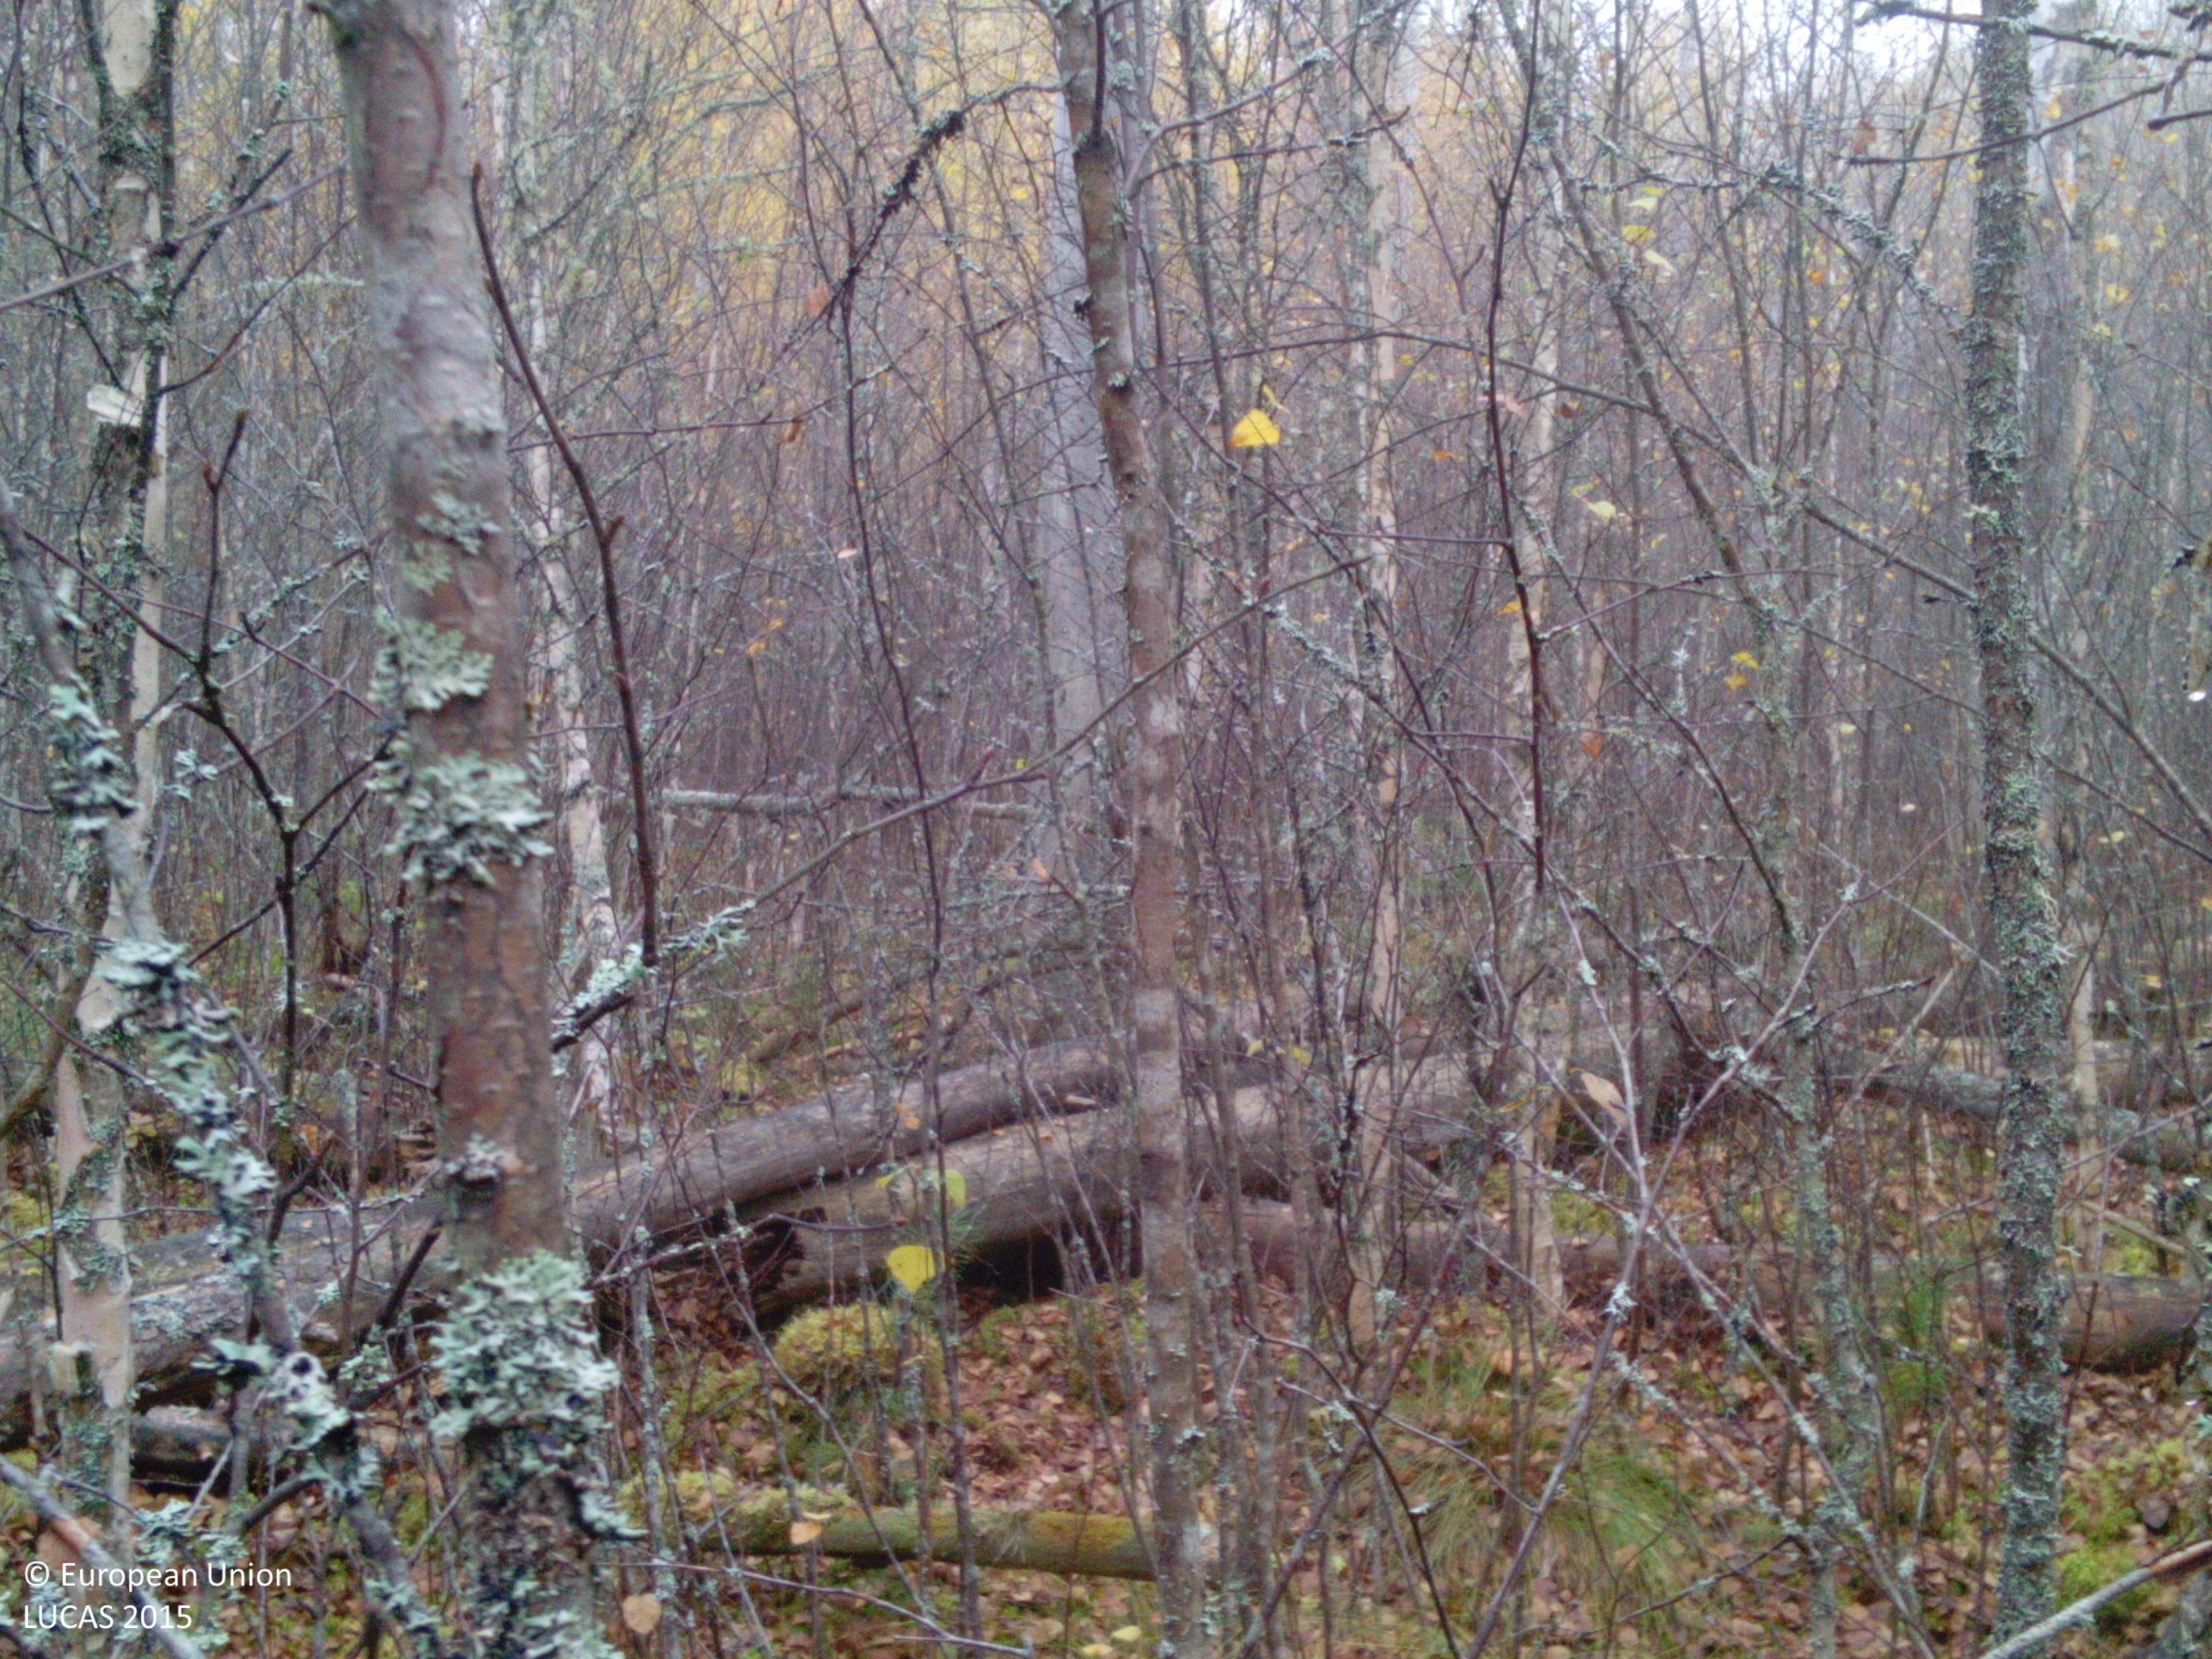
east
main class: Woodland
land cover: Broadleaved woodland
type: hemiboreal forest and nemoral coniferous forest and mixed broadleaved-coniferous forest
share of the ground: > 75 %
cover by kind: broadleaved forest trees 85 %, herbaceous plants 10 %, lichens and mosses 5 %
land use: Forestry
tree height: < 5 m
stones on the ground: < 10 %
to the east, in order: Broadleaved woodland; Spontaneously vegetated surfaces; Broadleaved woodland; Grassland with sparse tree/shrub cover; Spontaneously vegetated surfaces; Grassland without tree/shrub cover; Paved roads, cycling and walking lanes; Grassland without tree/shrub cover; Ditches and canals; Pine dominated coniferous woodland; Paved roads, cycling and walking lanes; Broadleaved woodland; Pine dominated mixed woodland
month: October
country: SE
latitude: 58.9334
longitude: 16.4053
